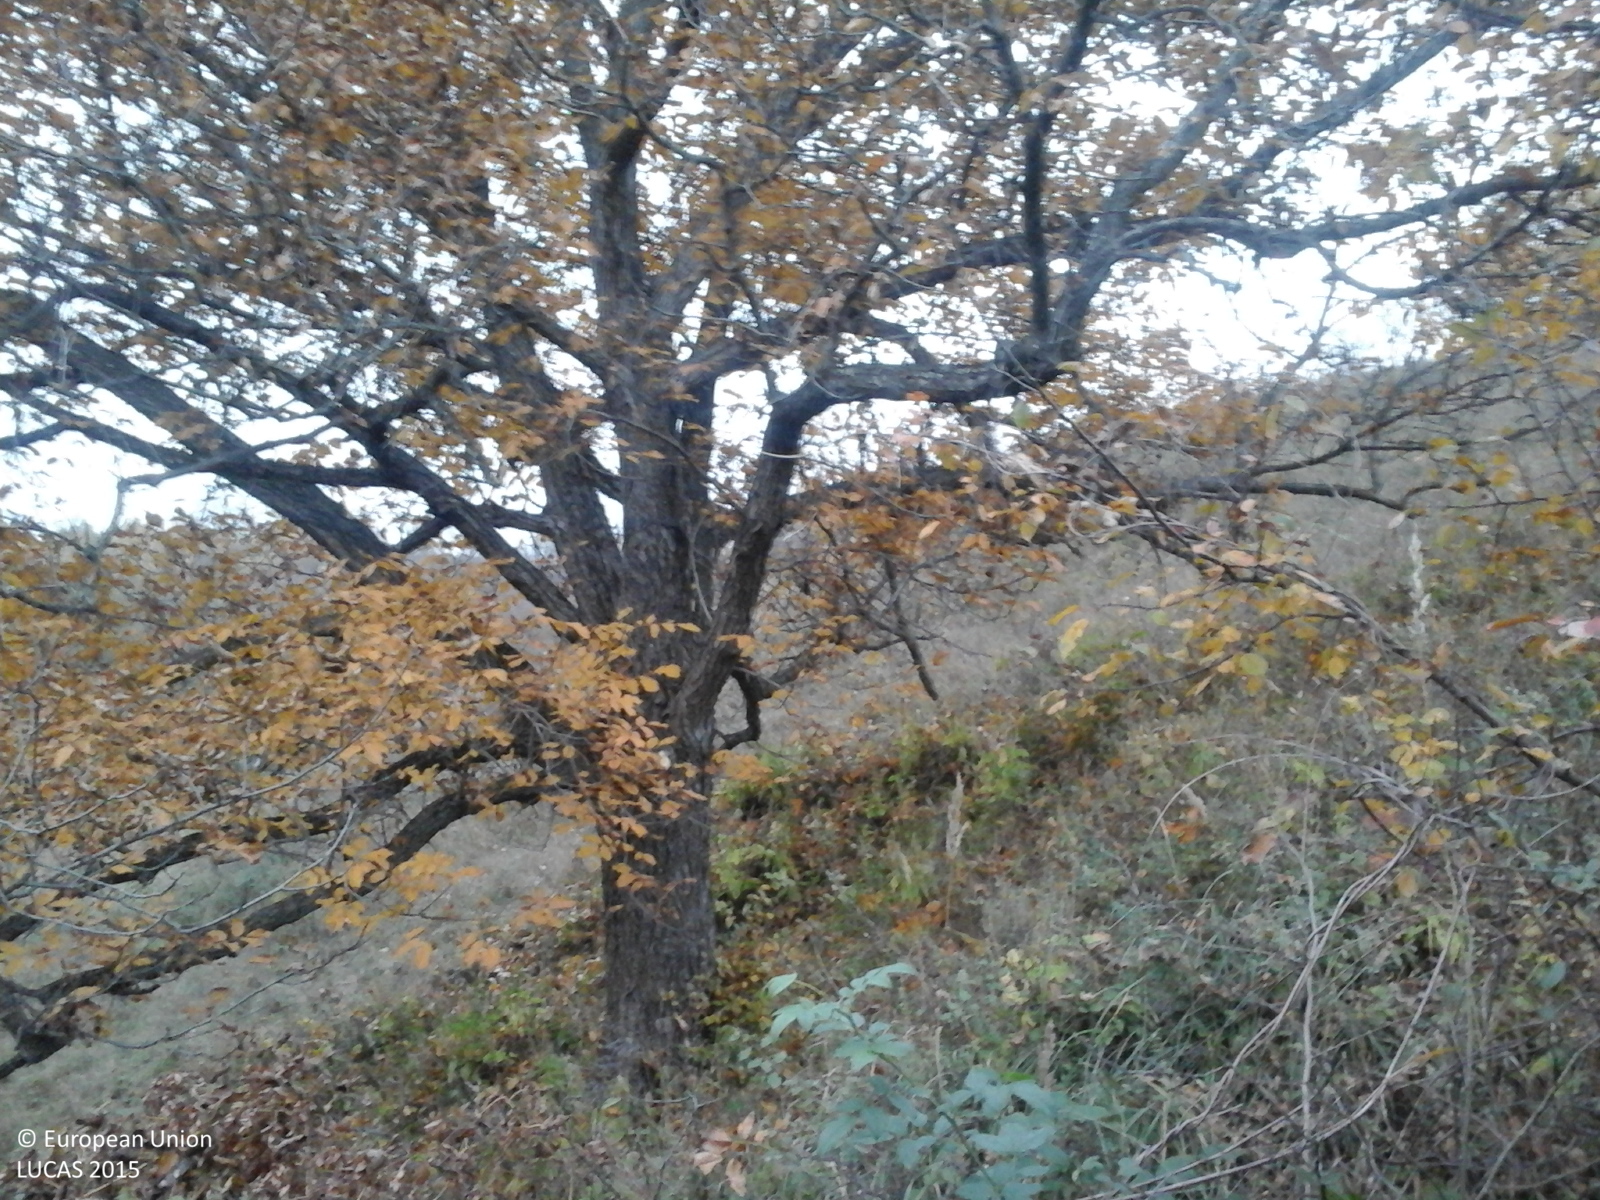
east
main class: Shrubland
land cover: Shrubland with sparse tree cover
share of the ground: > 75 %
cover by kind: shrubs 85 %, herbaceous plants 10 %, broadleaved forest trees 5 %
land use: Semi-natural and natural areas not in use
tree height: < 5 m
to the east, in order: Shrubland with sparse tree cover; Grassland without tree/shrub cover; Single bushes/trees; Grassland without tree/shrub cover; Tracks; Grassland without tree/shrub cover; Abandoned hedges; Fences; Grassland without tree/shrub cover; Other fruit trees and berries; Abandoned hedges; Fences; Grassland without tree/shrub cover; Fences; Spontaneously vegetated surfaces; Tracks; Fences; Abandoned hedges; Grassland with sparse tree/shrub cover; Abandoned hedges; Fences; Tracks; Fences; Grassland with sparse tree/shrub cover; Fences
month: October
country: RO
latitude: 45.3562
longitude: 26.4758
